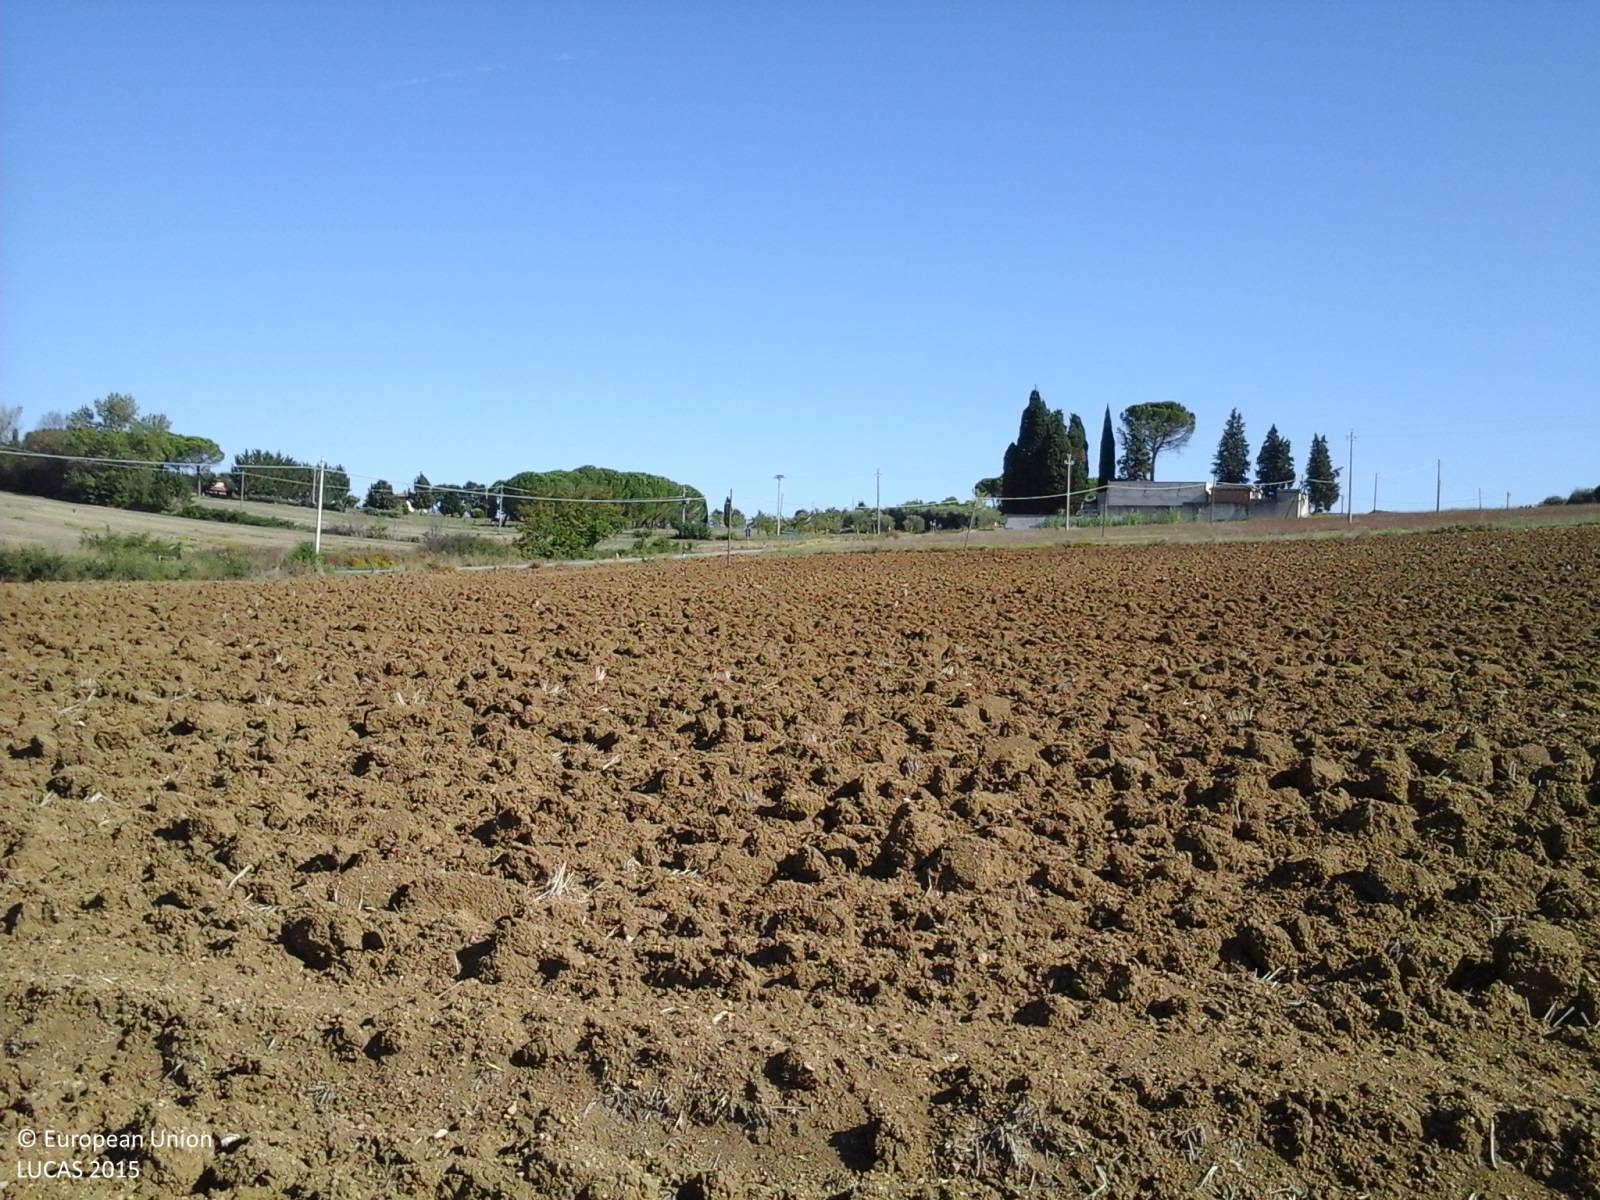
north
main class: Cropland
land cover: Common wheat
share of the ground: < 10 %
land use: Agriculture (excluding fallow land and kitchen gardens)
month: September
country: IT
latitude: 43.0251
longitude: 12.3125
